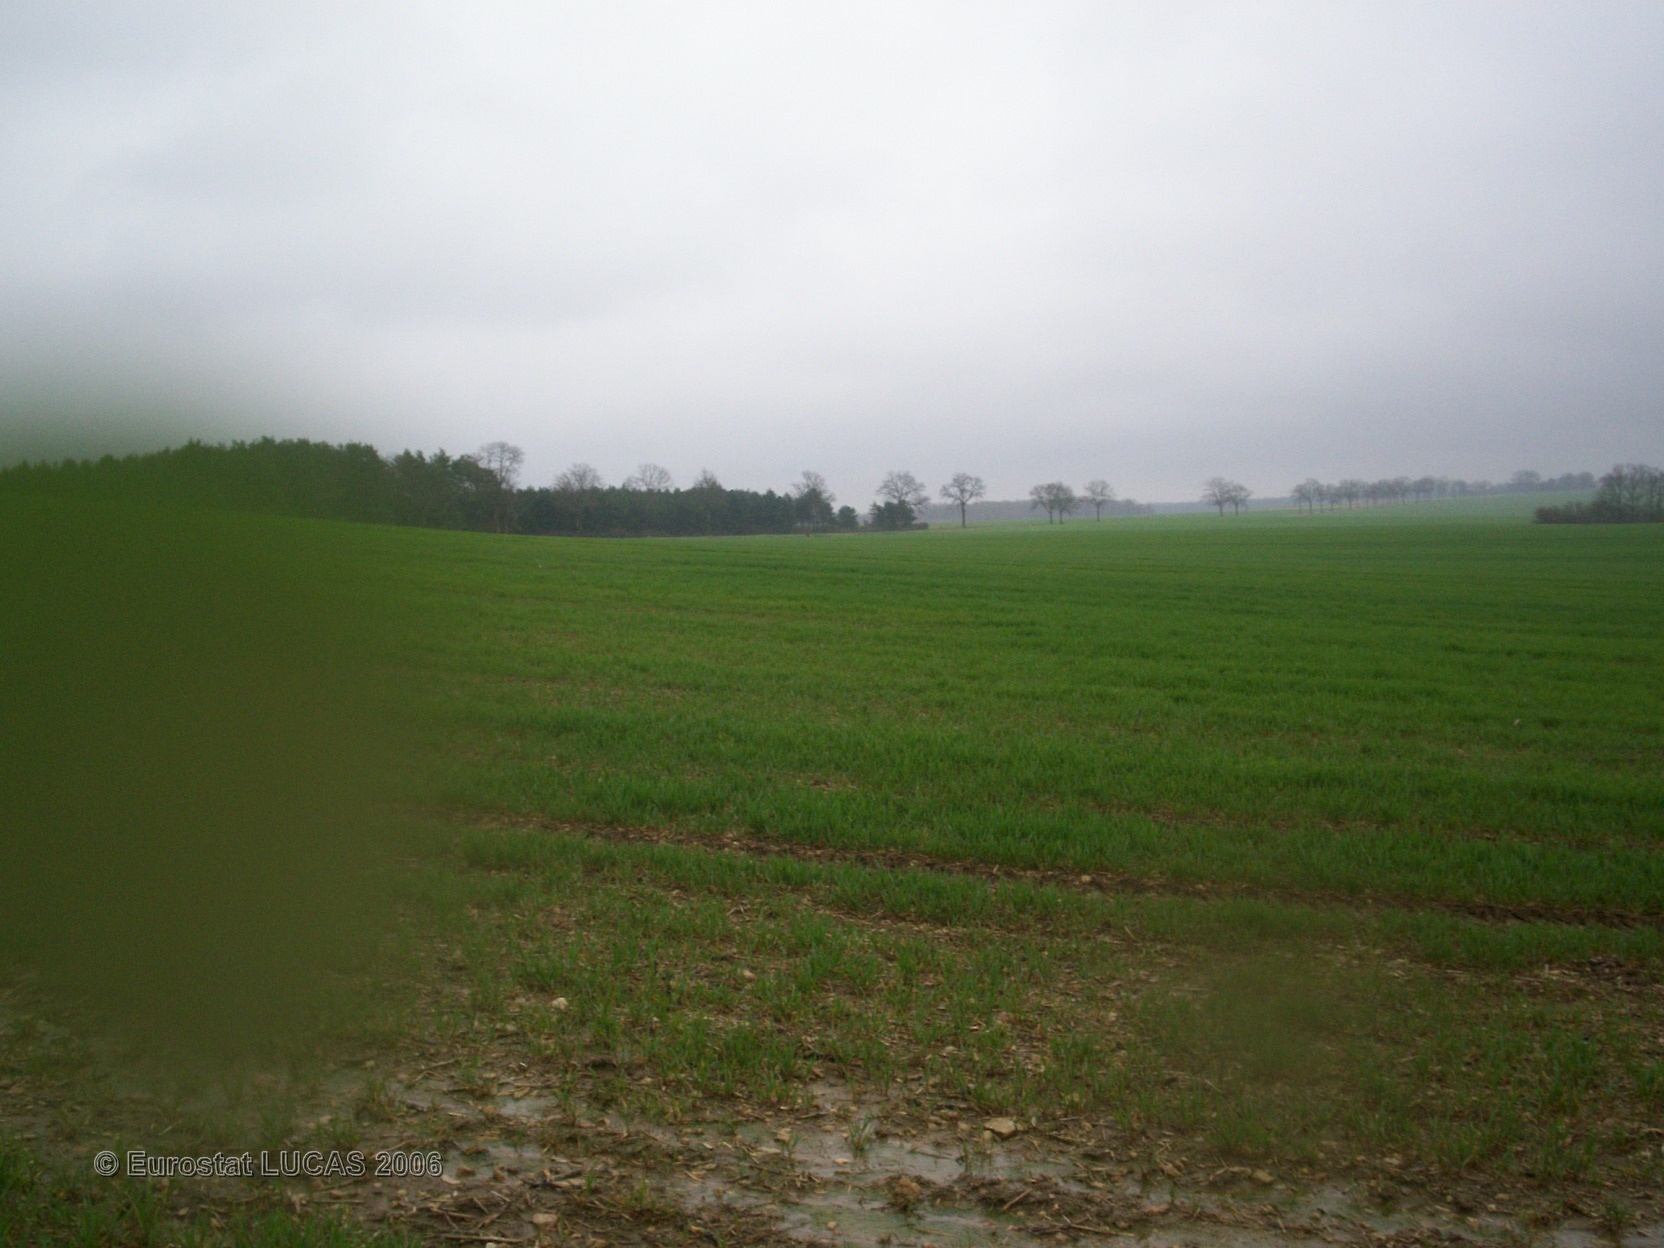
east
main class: Cropland
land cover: Barley
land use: Agriculture (excluding fallow land and kitchen gardens)
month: April
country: FR
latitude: 48.0932
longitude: 4.6410
